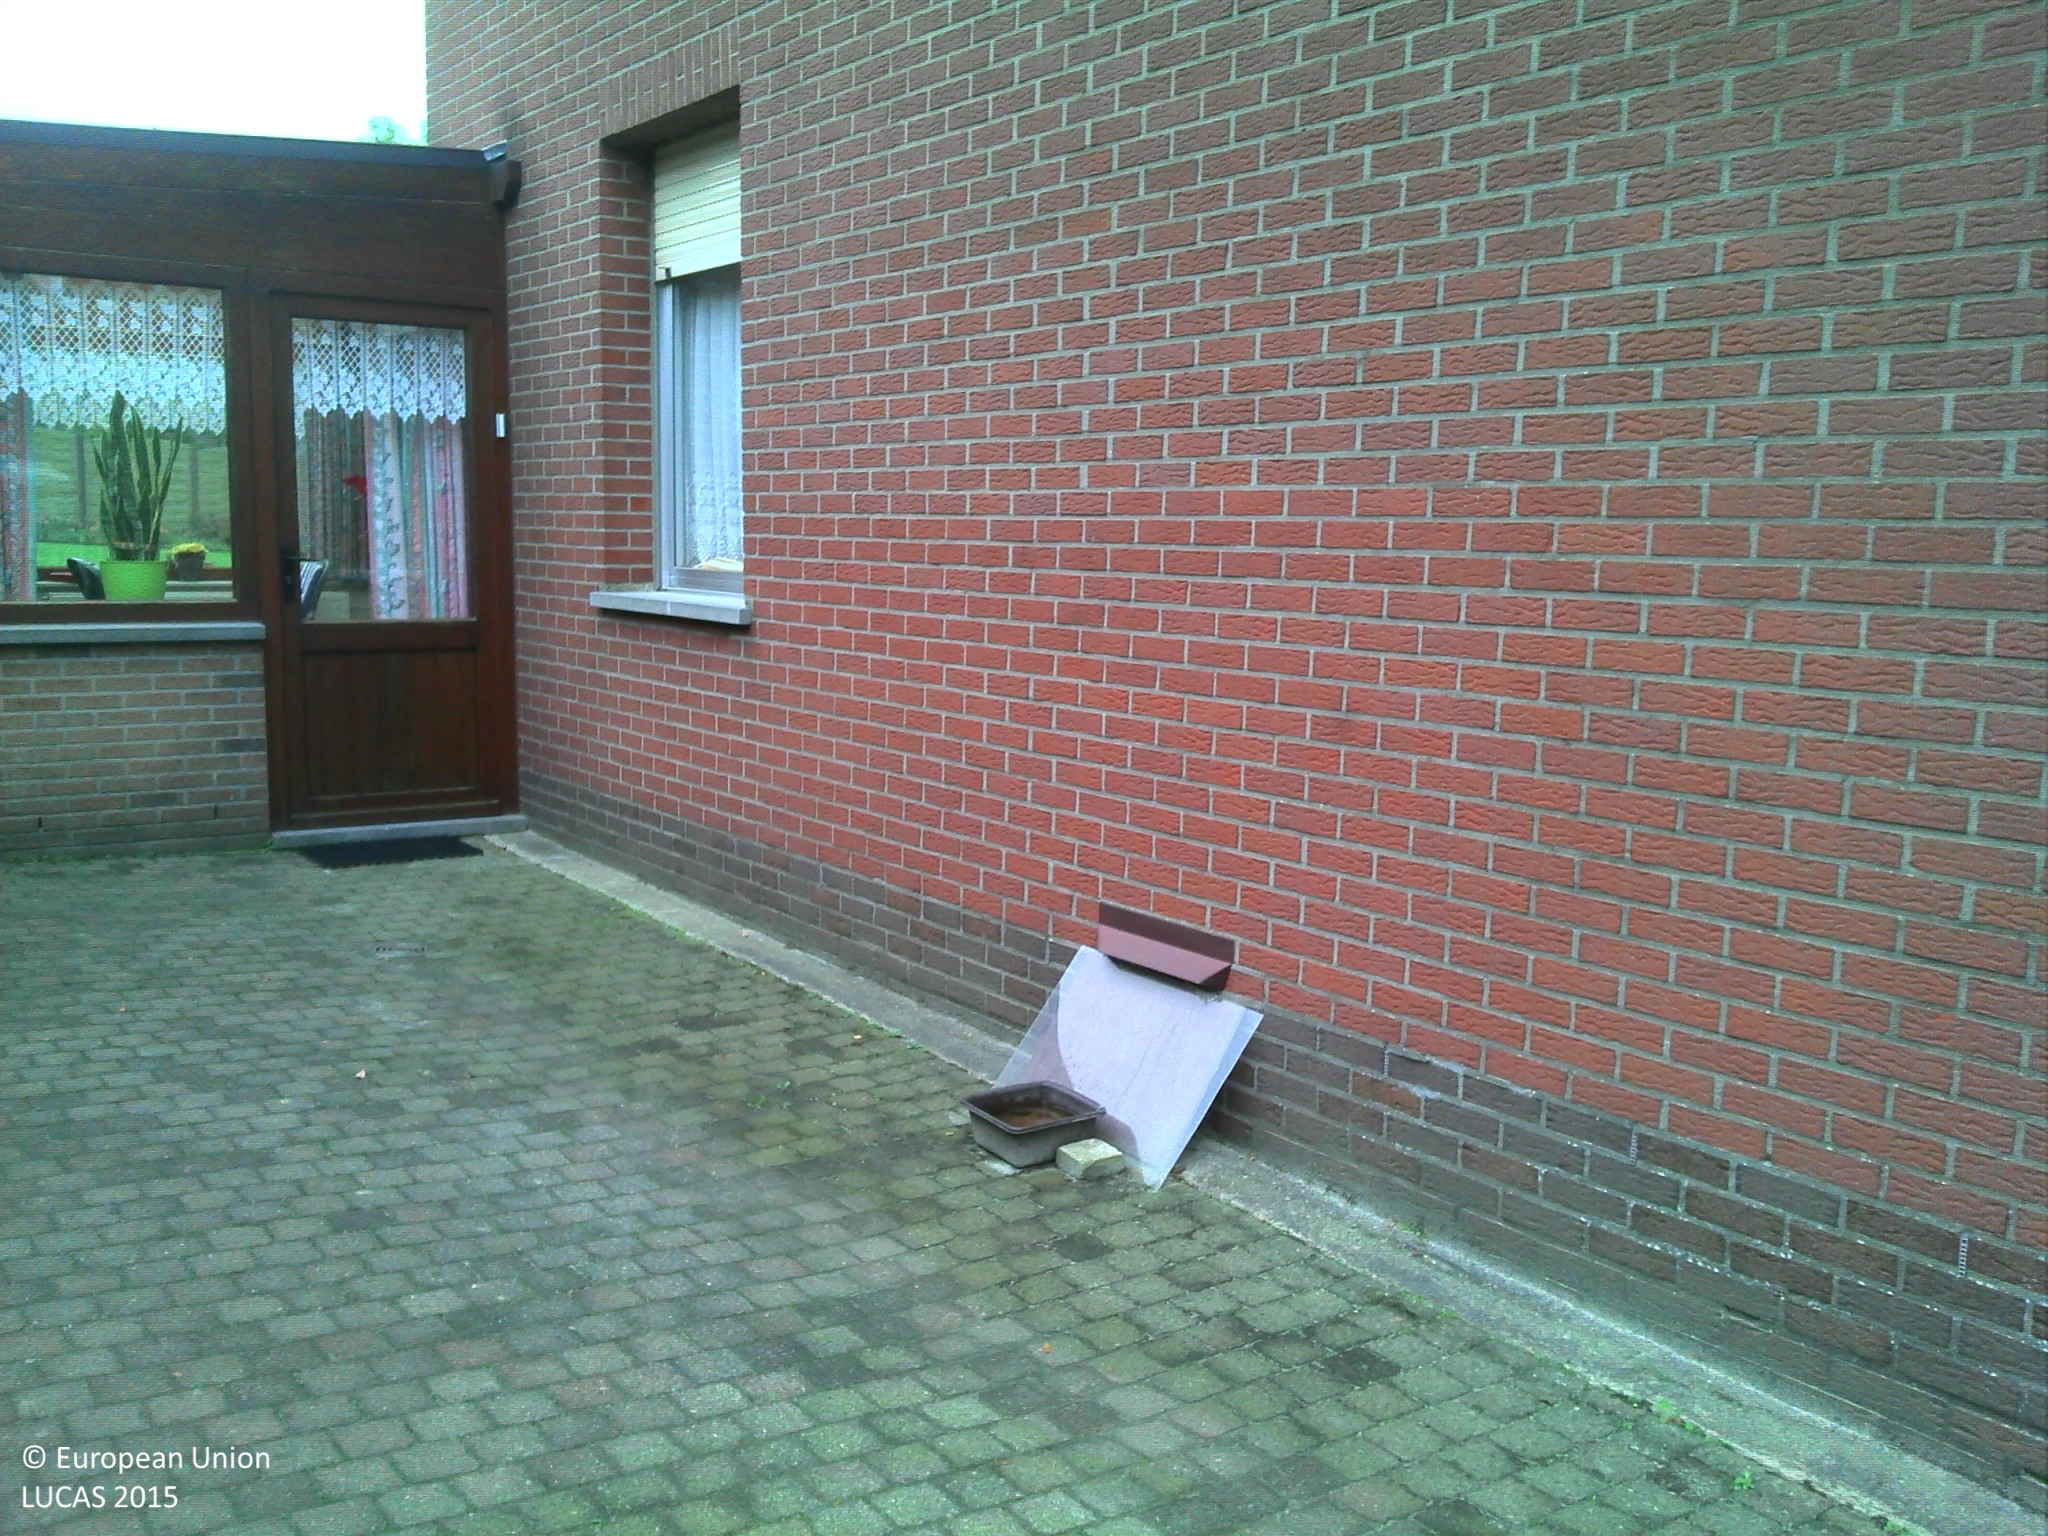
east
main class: Grassland
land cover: Grassland without tree/shrub cover
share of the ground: > 75 %
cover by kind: herbaceous plants 95 %, shrubs 5 %
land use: Residential
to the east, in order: Grassland without tree/shrub cover; Artificial constructions in urban areas; Ditches and canals; Broadleaved woodland
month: October
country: BE
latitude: 50.8485
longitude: 4.5845
